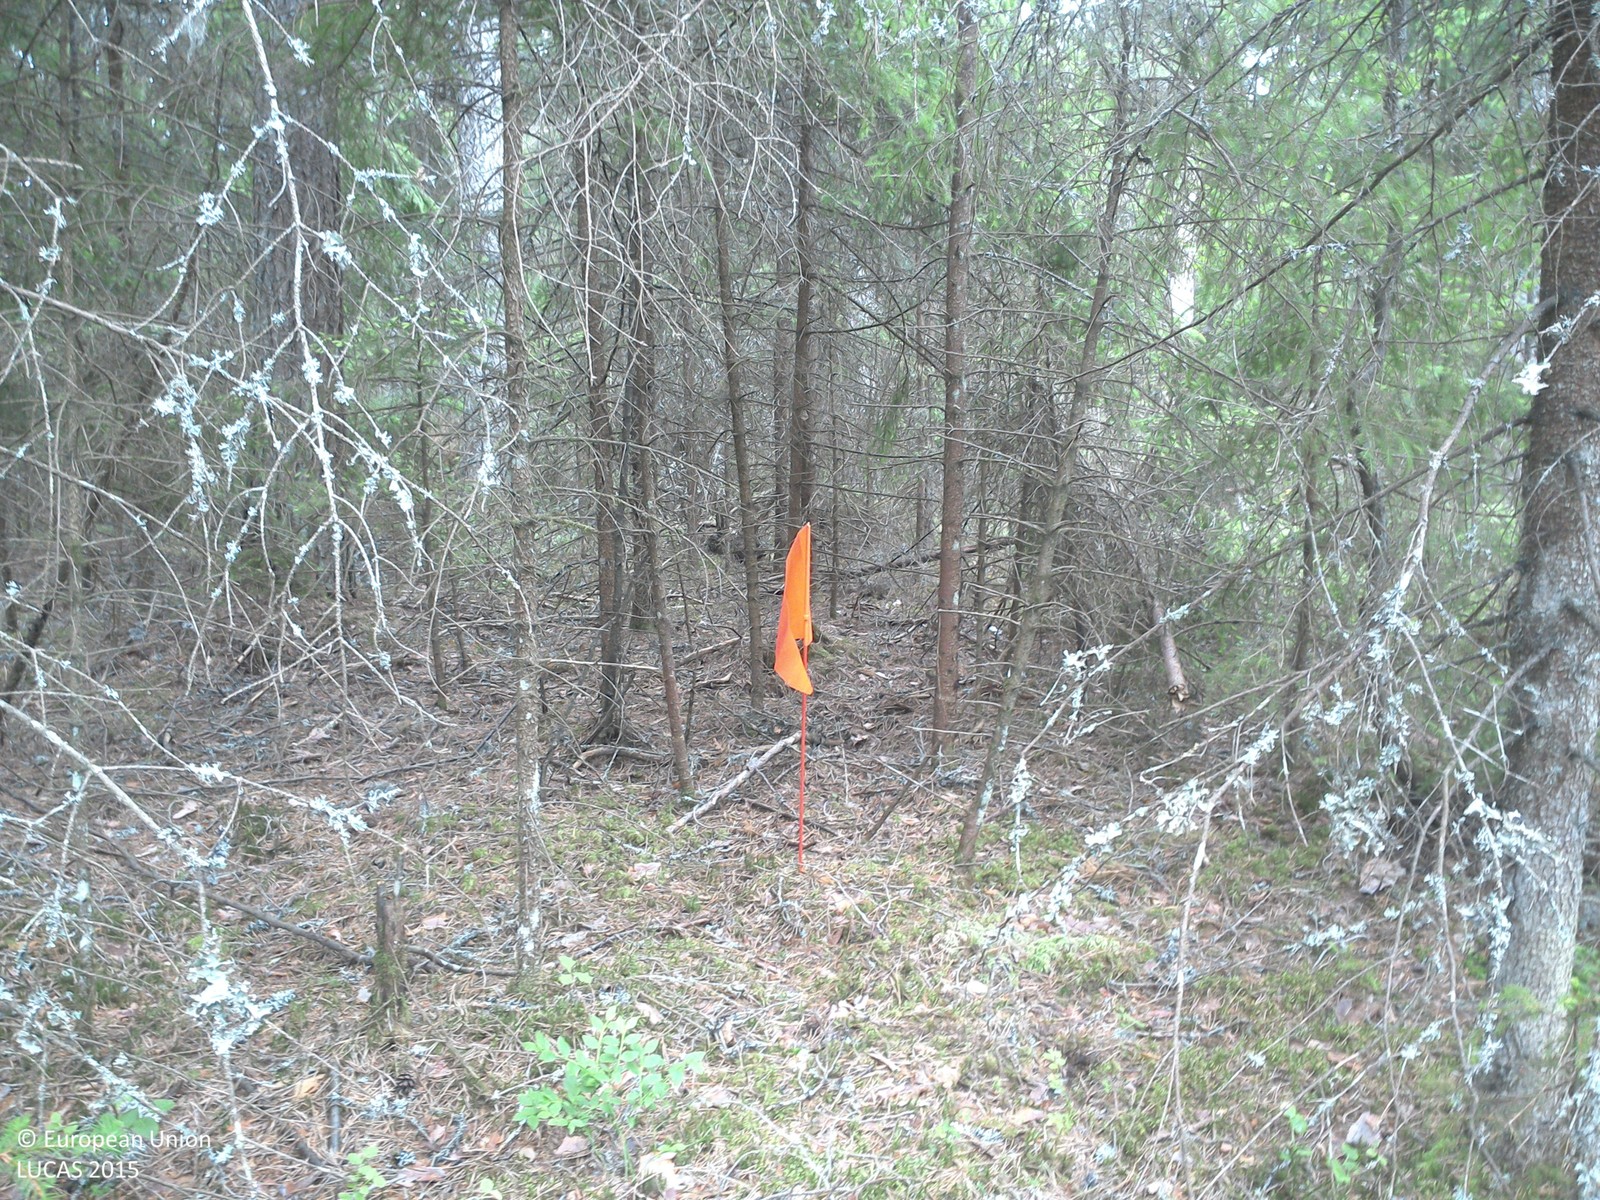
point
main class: Woodland
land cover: Spruce dominated coniferous woodland
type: boreal forest
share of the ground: > 75 %
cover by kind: coniferous forest trees 75 %, lichens and mosses 25 %
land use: Forestry
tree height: > 5 m
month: June
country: SE
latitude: 58.2471
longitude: 15.6001
